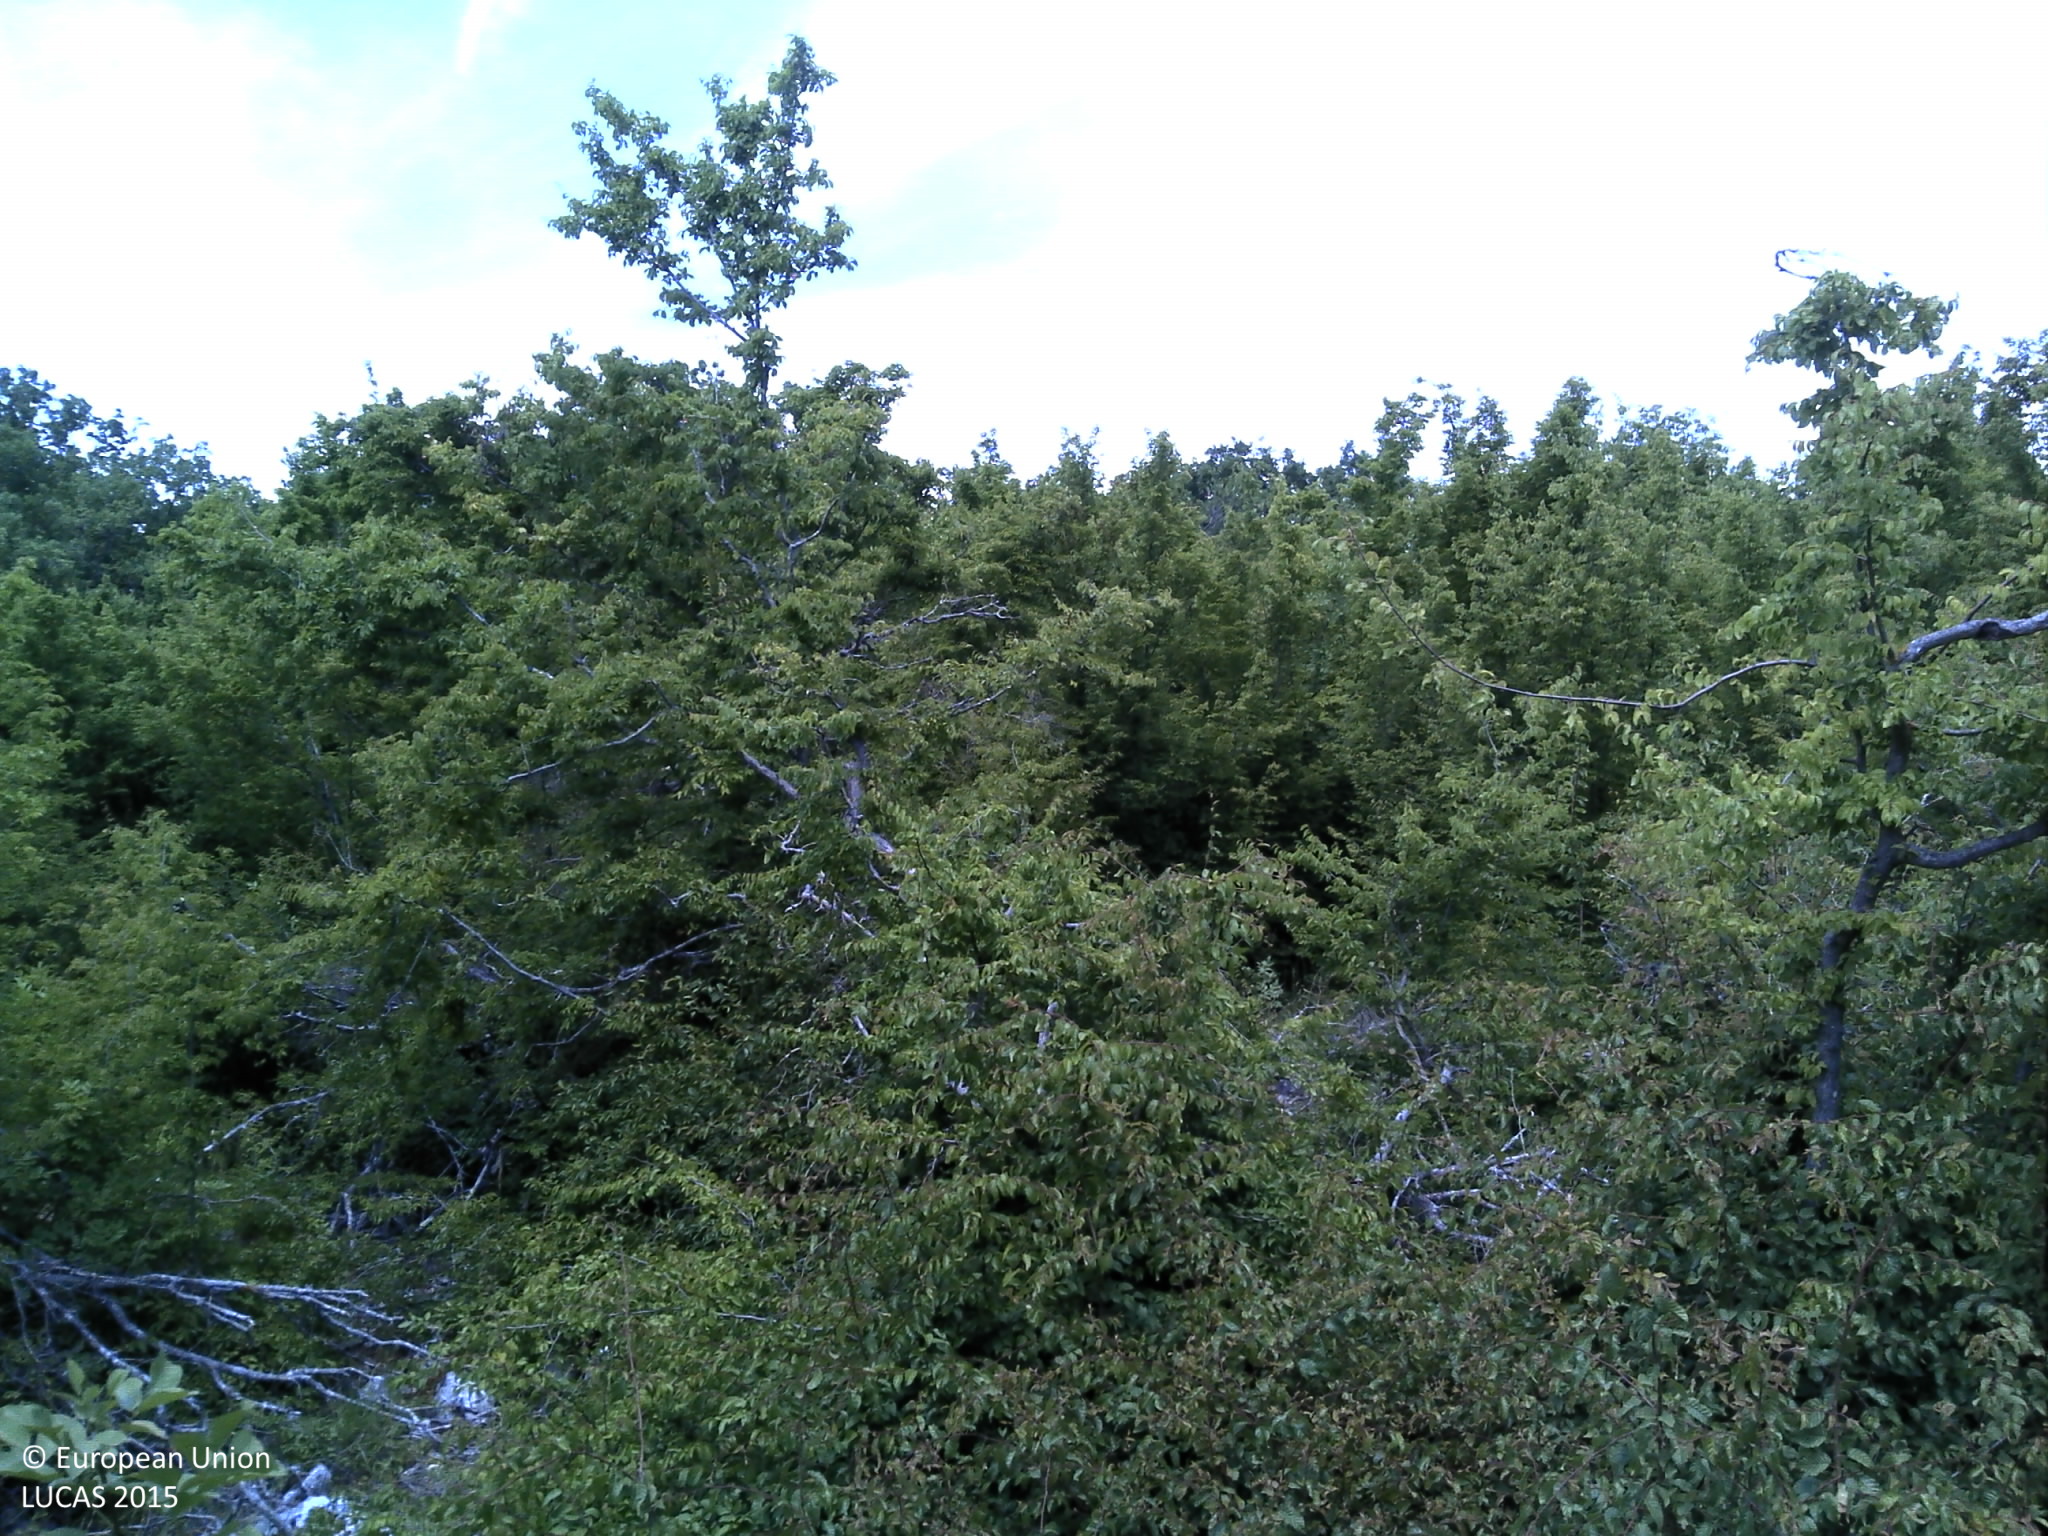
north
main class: Woodland
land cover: Broadleaved woodland
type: thermophilous deciduous forest
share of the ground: 25 - 50 %
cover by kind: shrubs 40 %, broadleaved forest trees 35 %, unconsolidated bare surface 15 %, coniferous forest trees 10 %
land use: Semi-natural and natural areas not in use
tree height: > 5 m
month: June
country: HR
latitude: 44.0671
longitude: 16.0226
